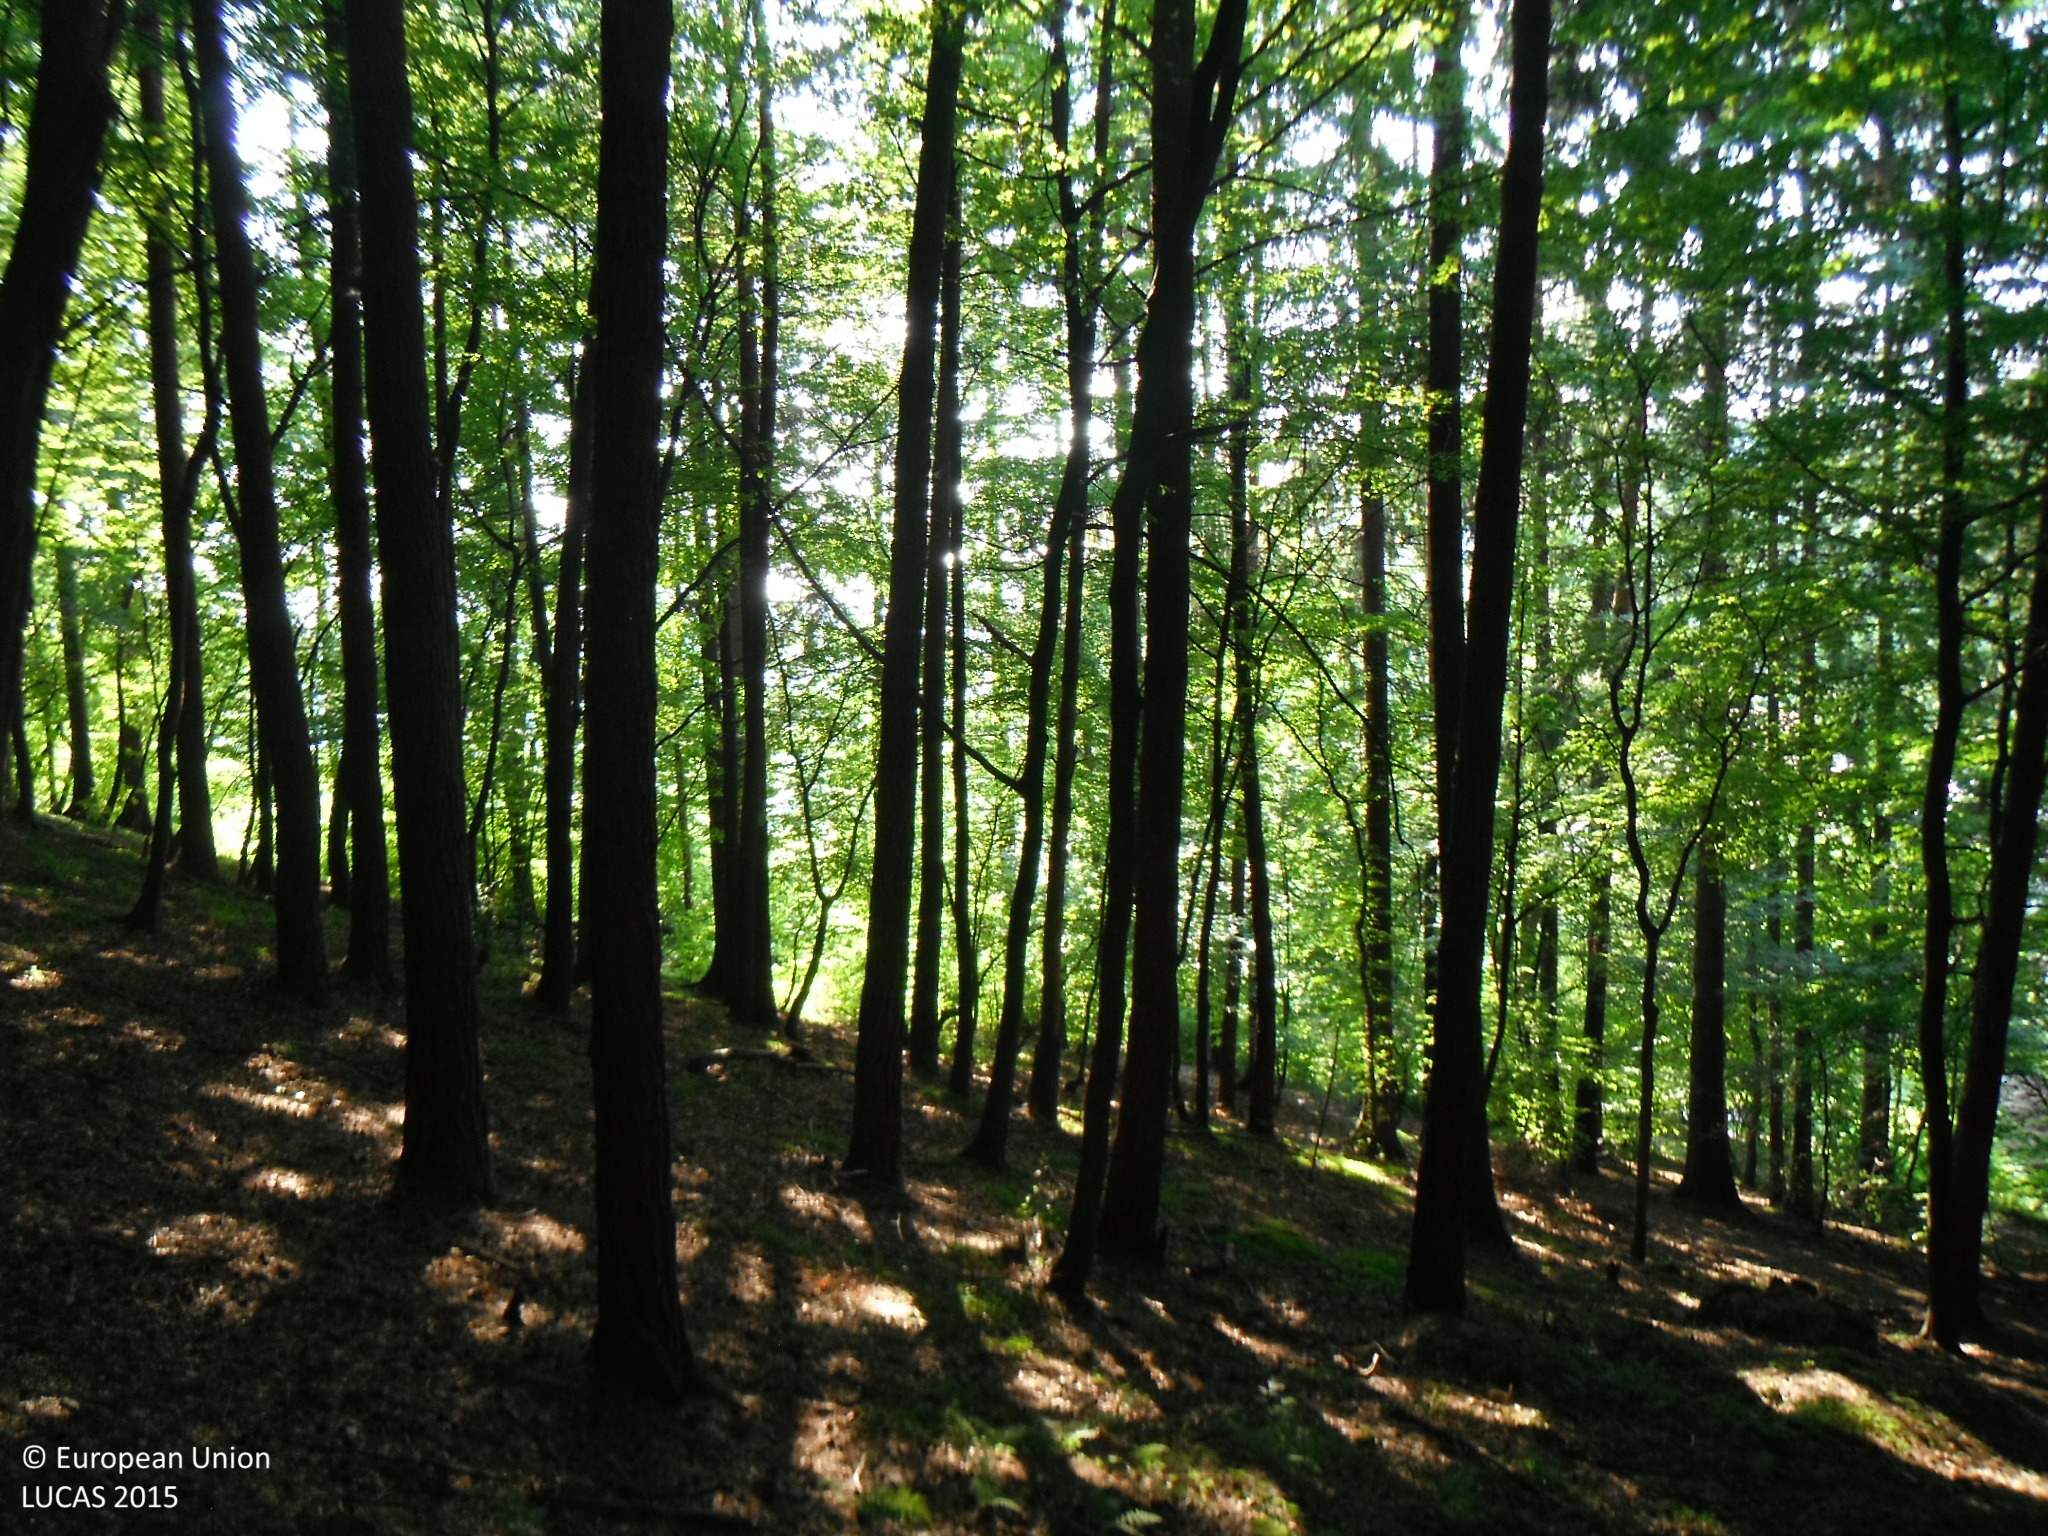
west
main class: Woodland
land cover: Pine dominated mixed woodland
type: hemiboreal forest and nemoral coniferous forest and mixed broadleaved-coniferous forest
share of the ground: > 75 %
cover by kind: coniferous forest trees 50 %, broadleaved forest trees 50 %
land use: Forestry
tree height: > 5 m
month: July
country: SK
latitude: 49.1091
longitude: 18.4699
